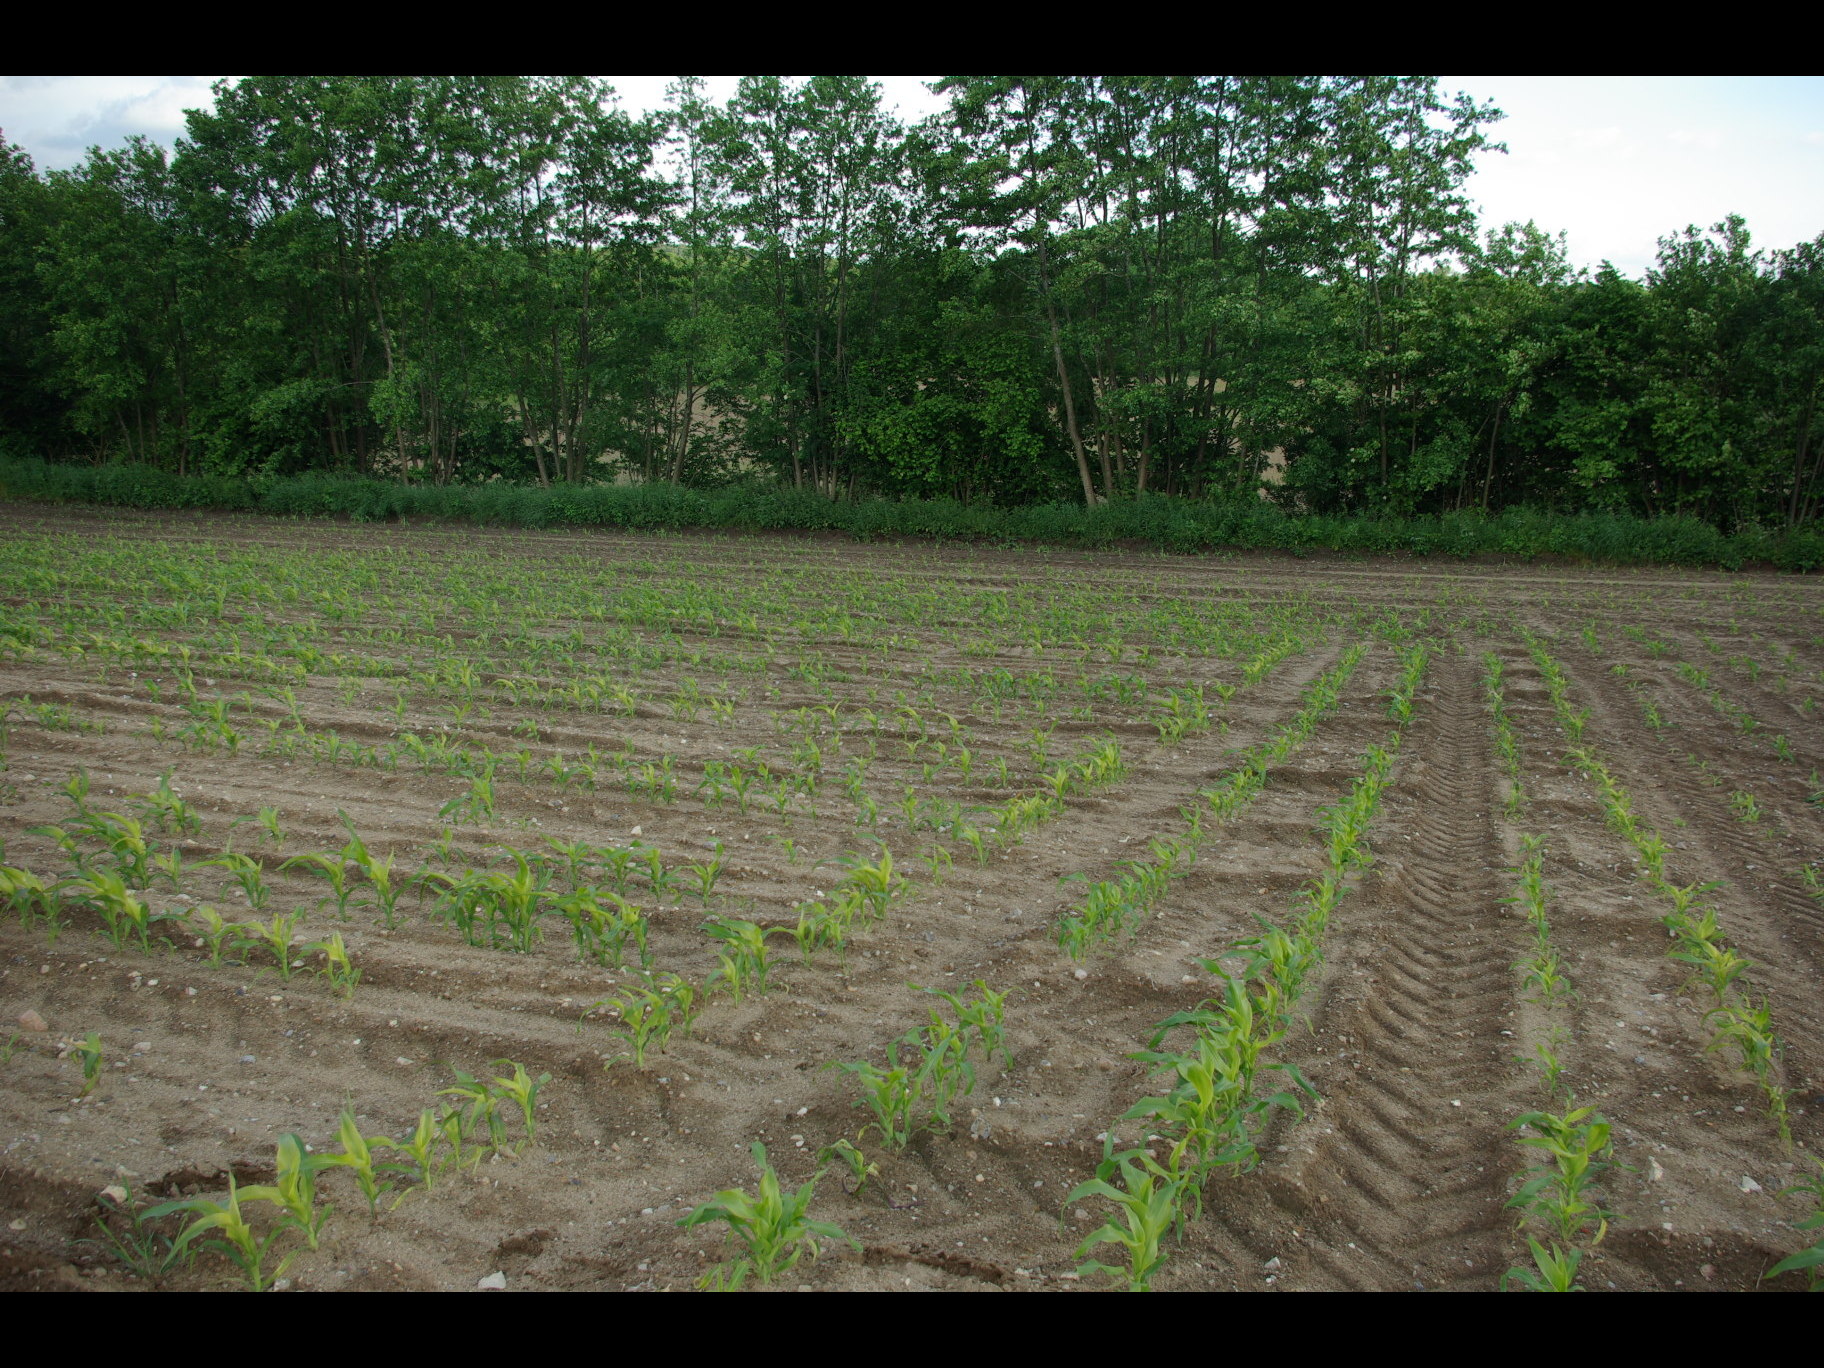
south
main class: Cropland
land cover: Maize
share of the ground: 10 - 25 %
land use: Agriculture (excluding fallow land and kitchen gardens)
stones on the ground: > 50 %
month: June
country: DE
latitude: 54.2286
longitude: 9.9233
